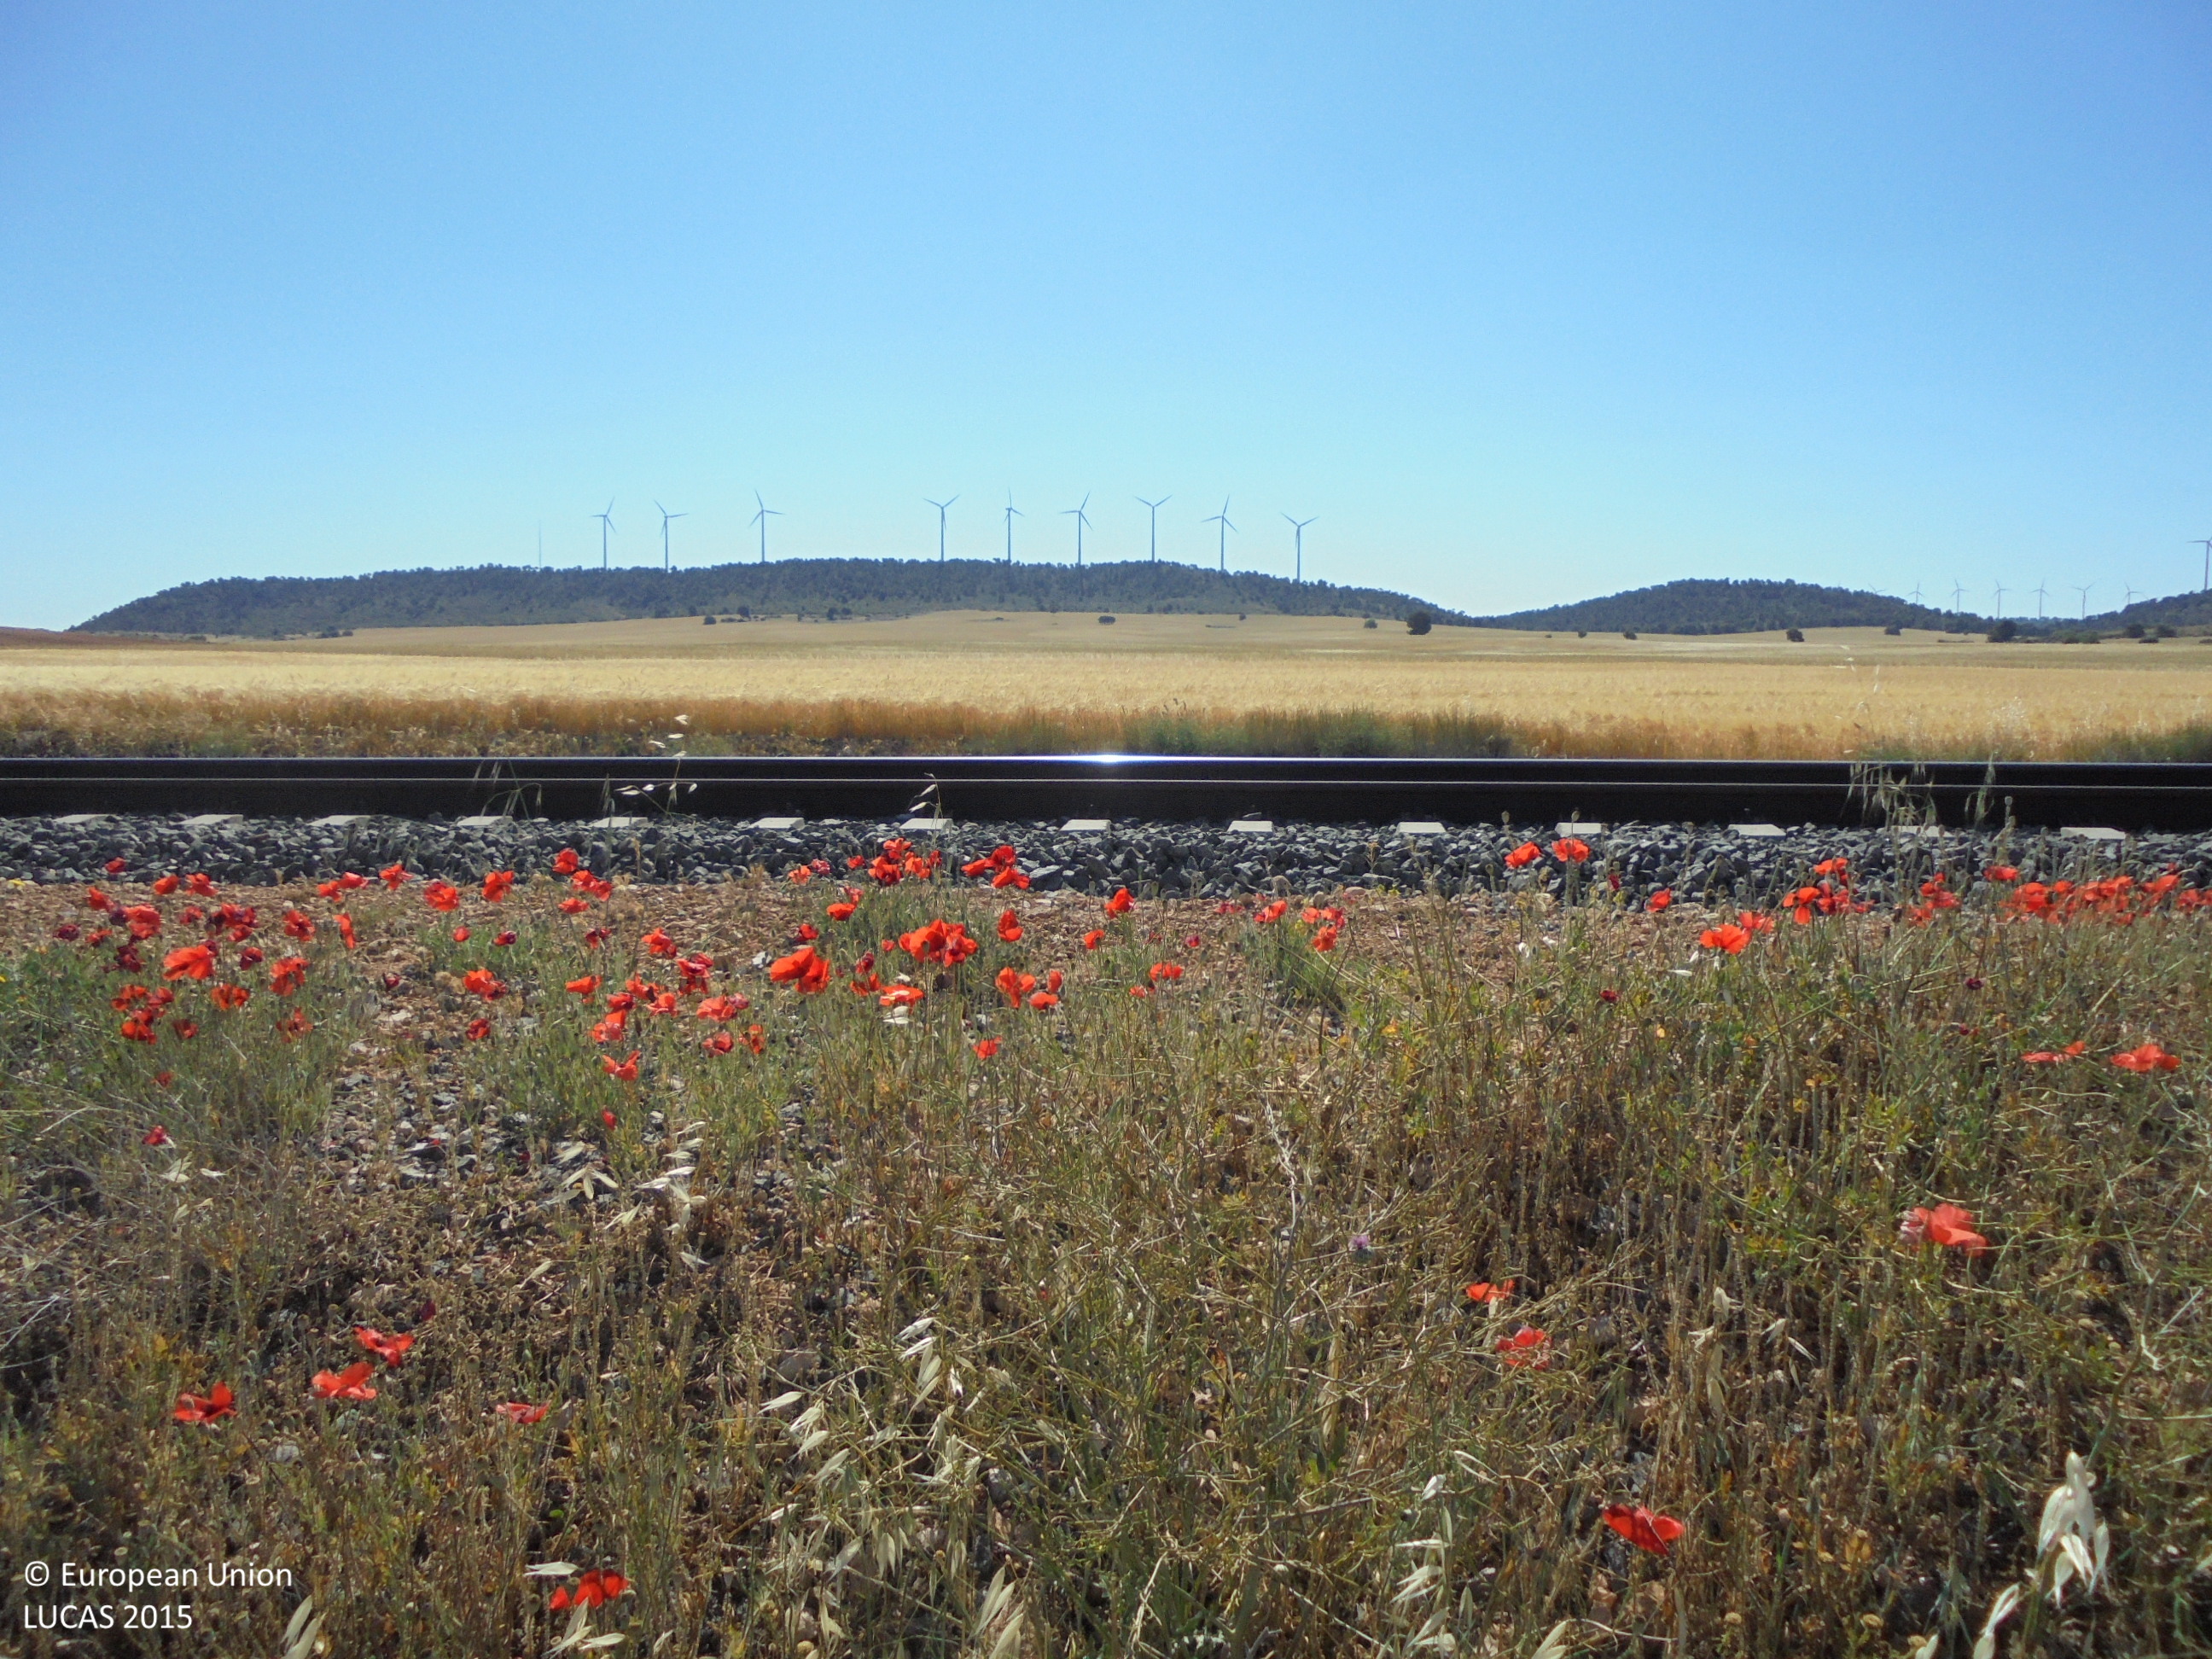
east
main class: Grassland
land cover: Grassland without tree/shrub cover
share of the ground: > 75 %
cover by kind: herbaceous plants 85 %, unconsolidated bare surface 15 %
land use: Semi-natural and natural areas not in use
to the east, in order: Grassland without tree/shrub cover; Railways; Grassland without tree/shrub cover; Barley; Grass margins; Durum wheat
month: June
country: ES
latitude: 38.8323
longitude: -1.7128
